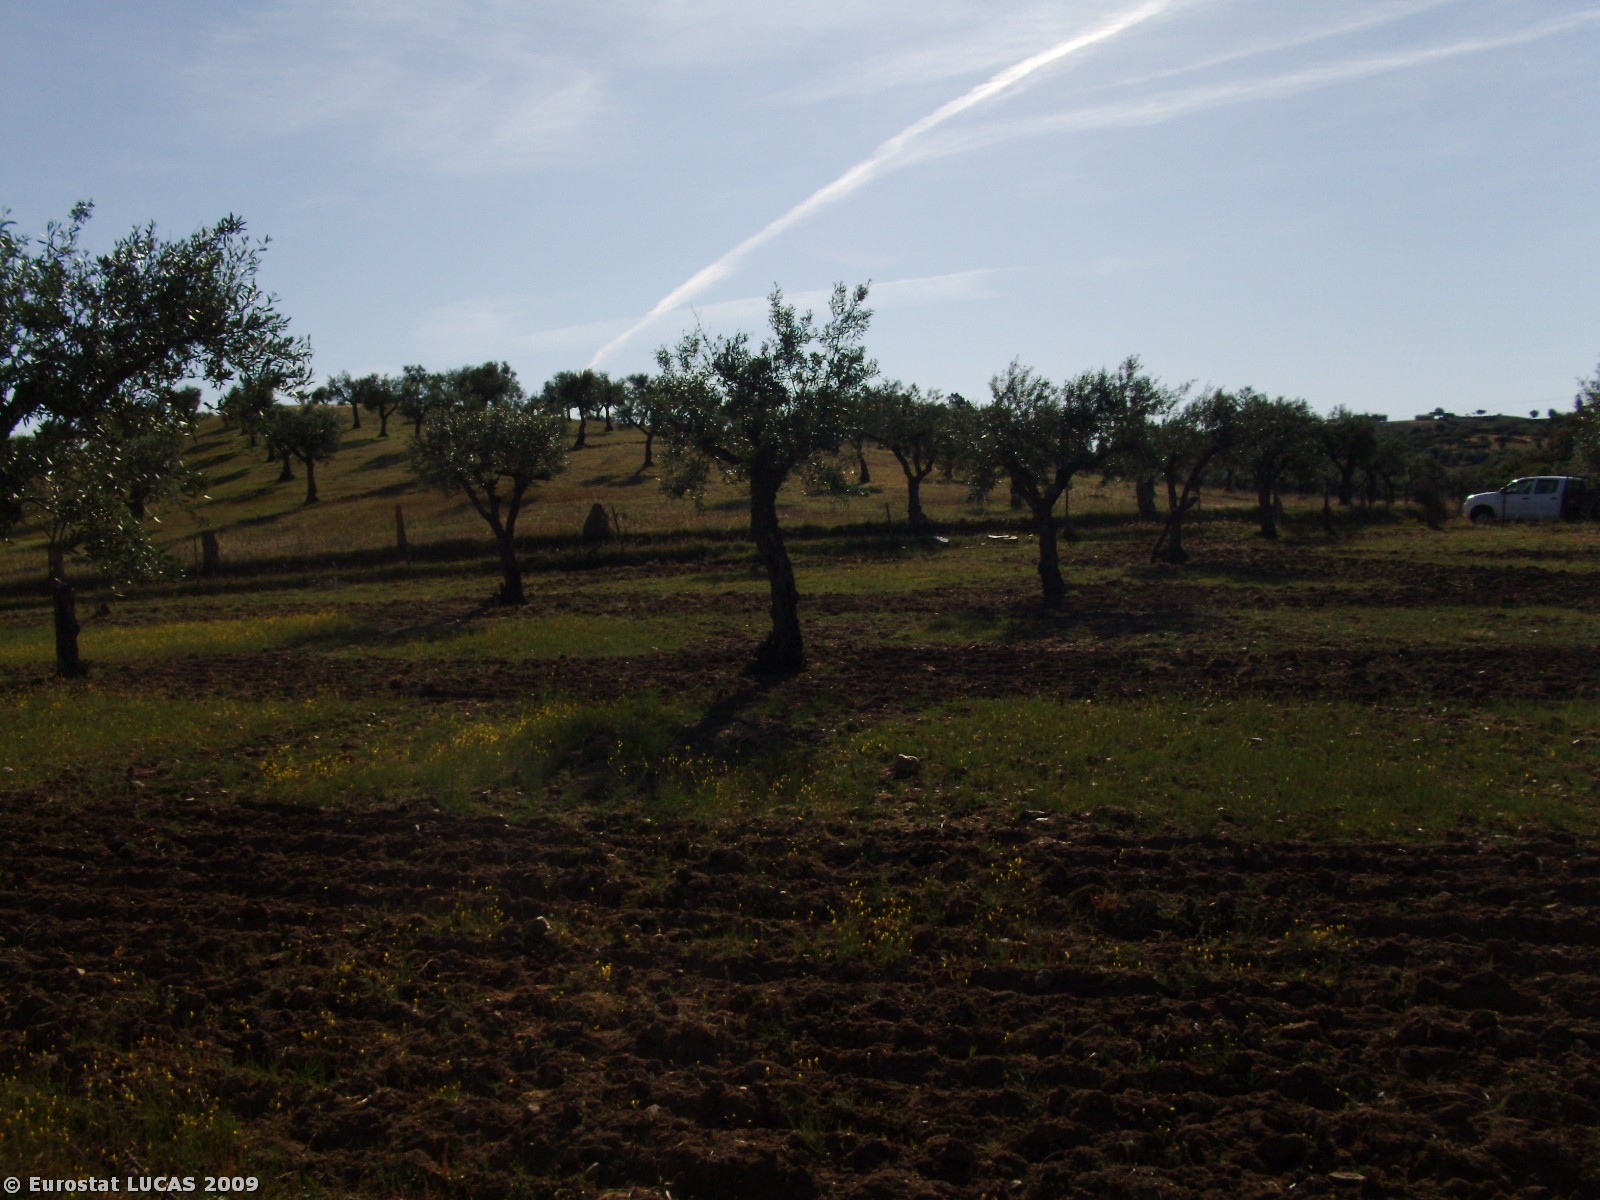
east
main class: Cropland
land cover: Olive groves
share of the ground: 10 - 25 %
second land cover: Spontaneously vegetated surfaces
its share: > 75 %
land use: Agriculture (excluding fallow land and kitchen gardens)
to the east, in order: Olive groves; Fences; Tracks; Fences; Olive groves; Fences; Oranges; Fences; Rivers and streams; Olive groves
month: May
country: PT
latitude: 39.6996
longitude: -7.5808
